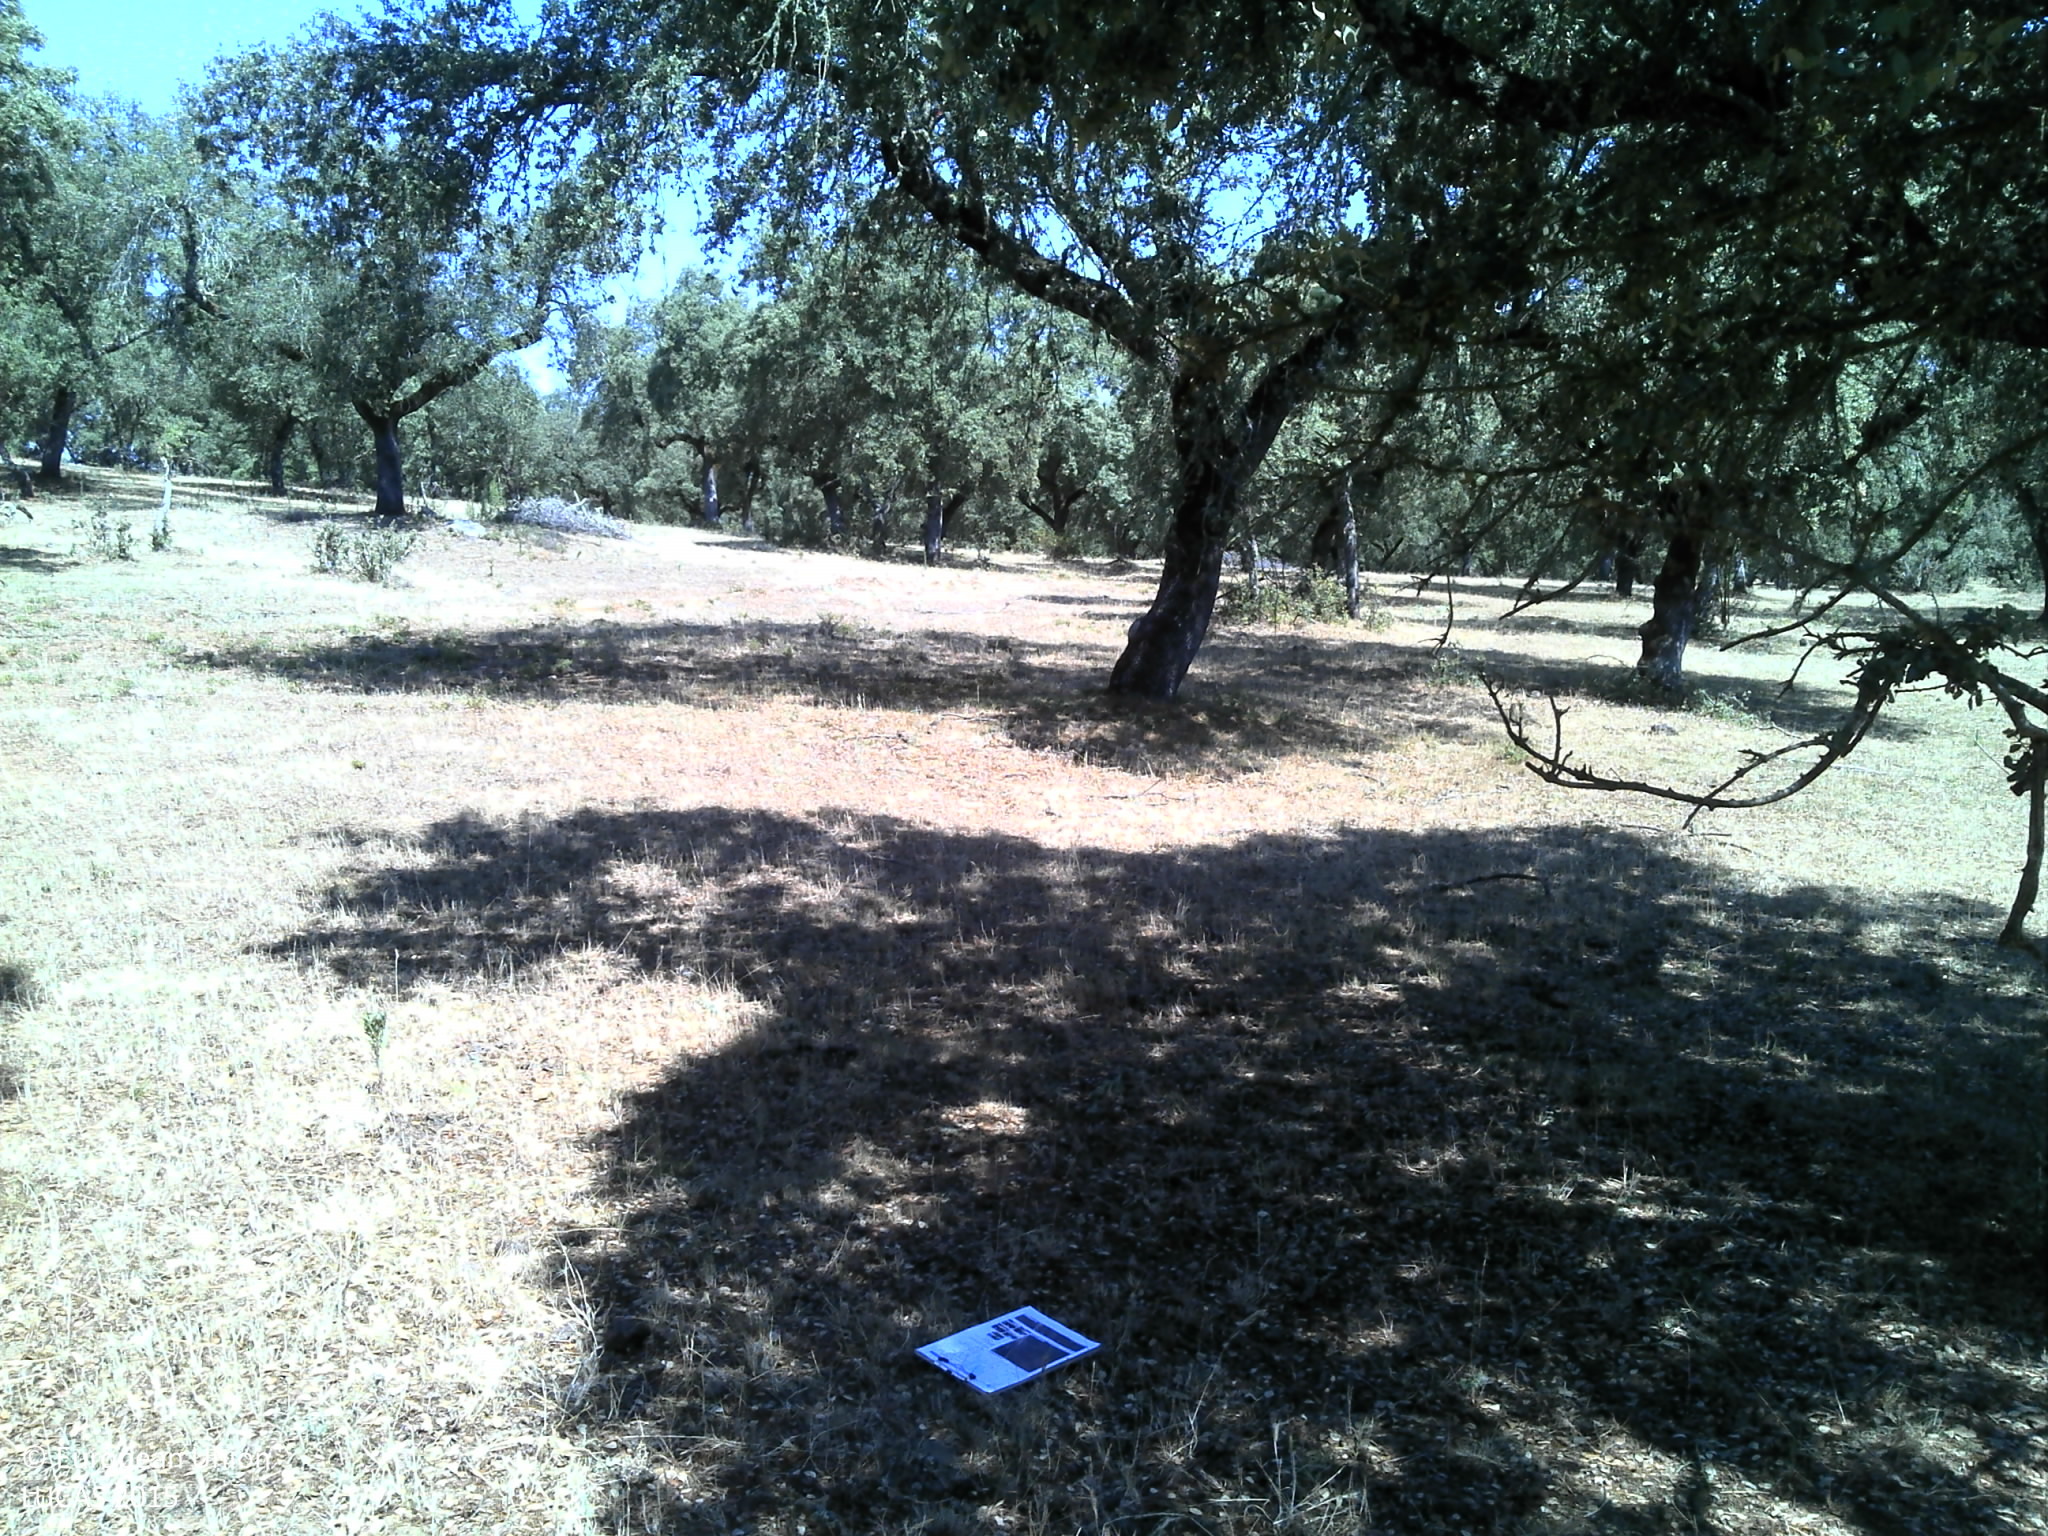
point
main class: Woodland
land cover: Broadleaved woodland
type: broadleaved evergreen forest
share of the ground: 50 - 75 %
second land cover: Grassland without tree/shrub cover
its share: 10 - 25 %
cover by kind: broadleaved forest trees 50 %, herbaceous plants 25 %, unconsolidated bare surface 25 %
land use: Forestry
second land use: Agriculture (excluding fallow land and kitchen gardens)
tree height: > 5 m
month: June
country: PT
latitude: 38.6428
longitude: -8.0949
